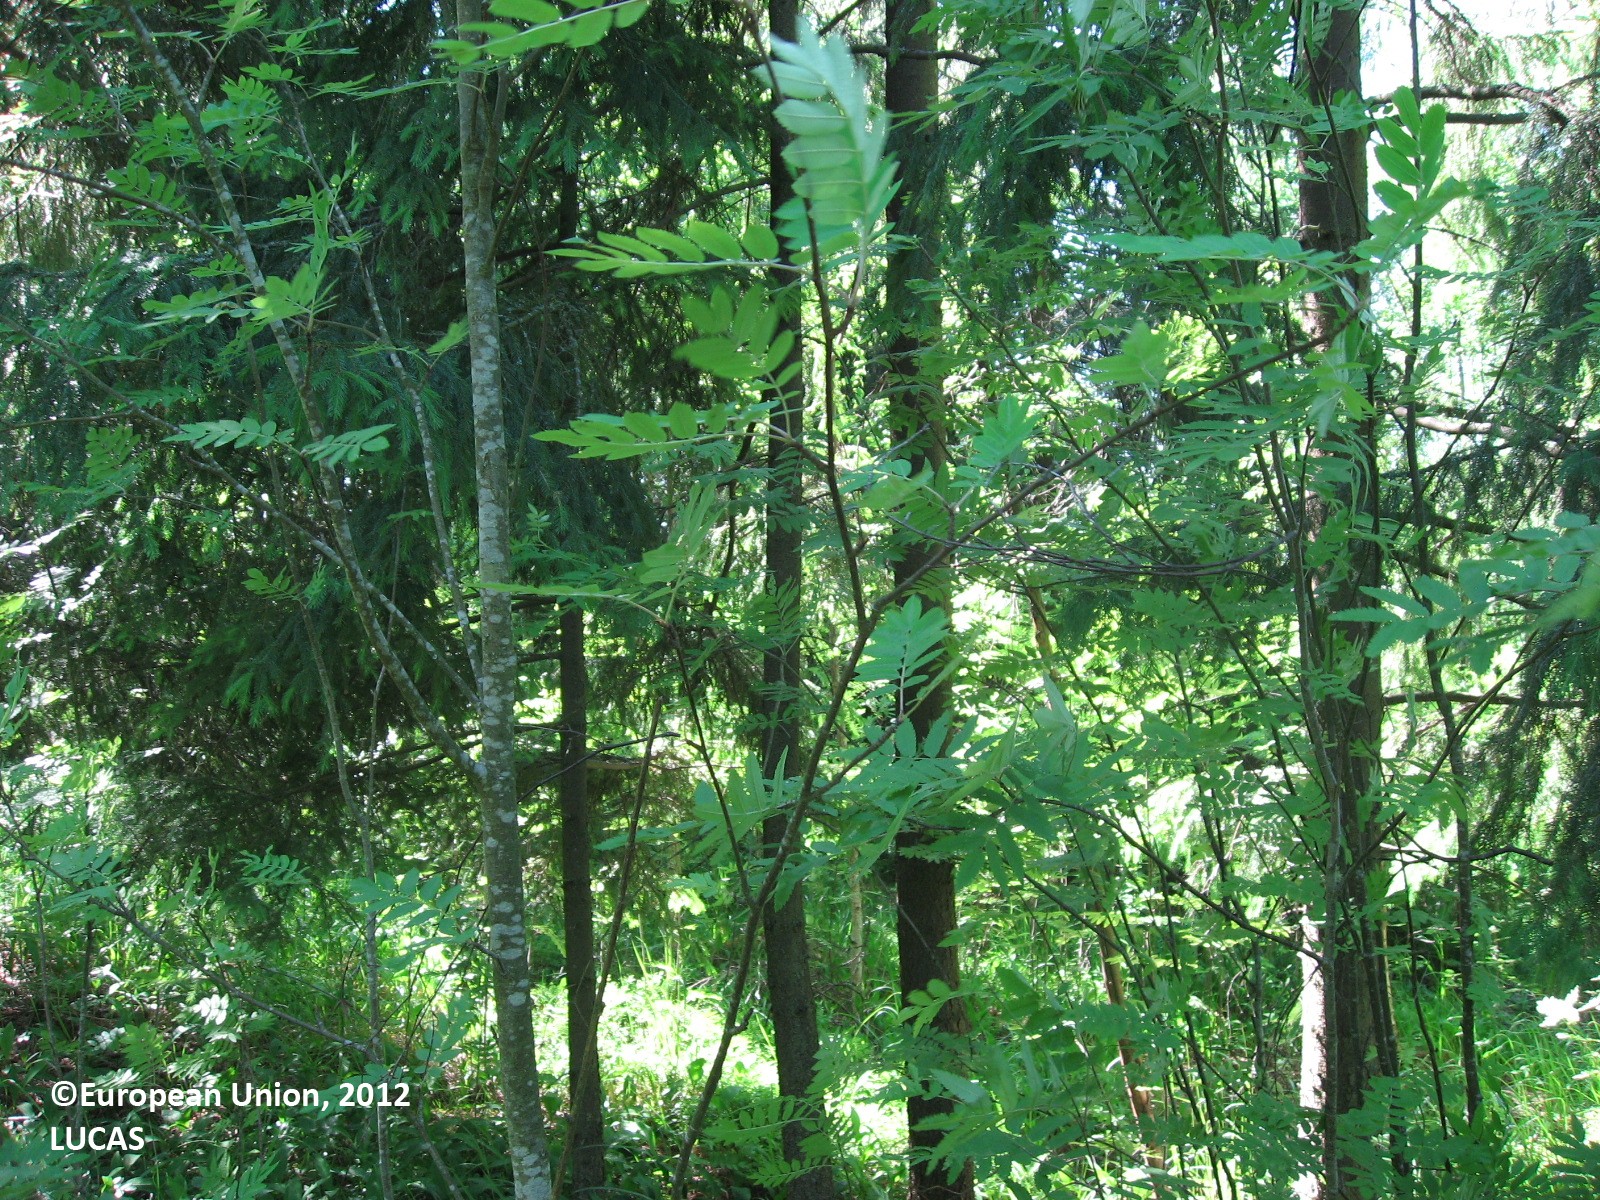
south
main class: Woodland
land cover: Spruce dominated mixed woodland
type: boreal forest
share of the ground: 50 - 75 %
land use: Forestry
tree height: > 5 m
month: June
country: FI
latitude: 60.5117
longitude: 24.9965
